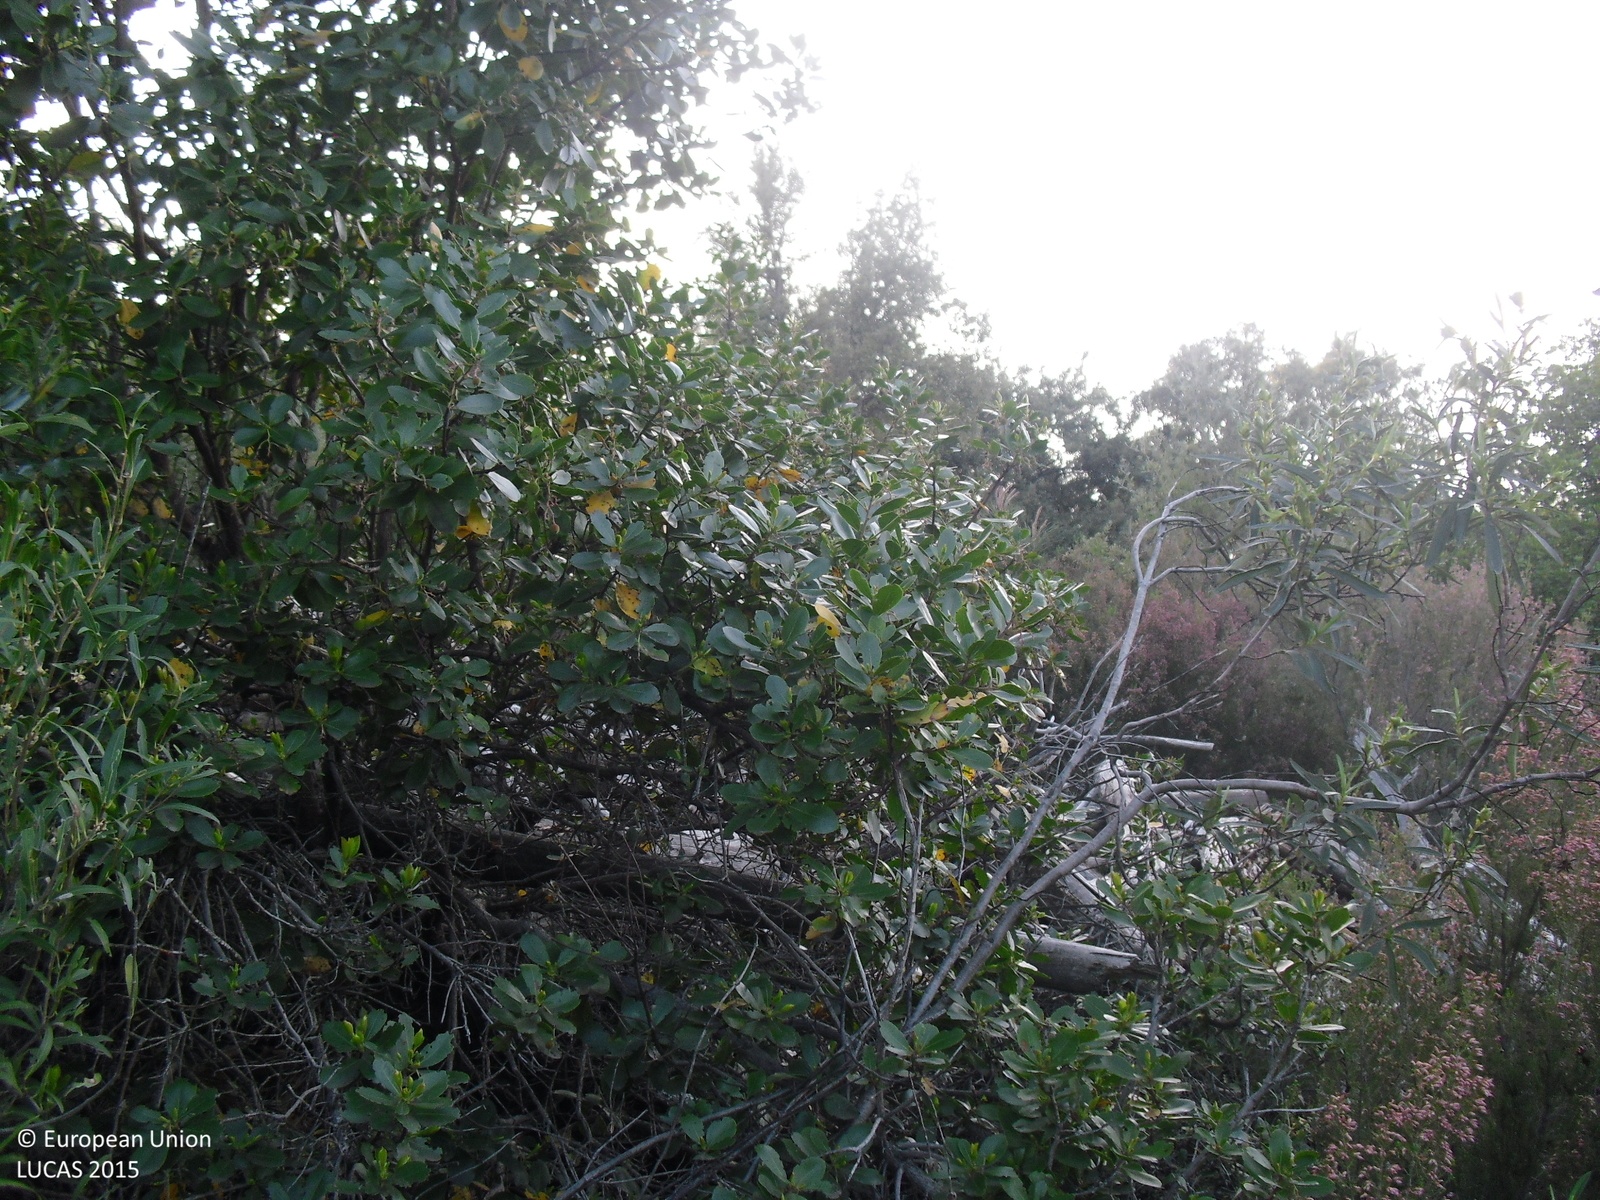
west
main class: Woodland
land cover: Broadleaved woodland
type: broadleaved evergreen forest
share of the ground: 10 - 25 %
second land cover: Shrubland without tree cover
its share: > 75 %
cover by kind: shrubs 70 %, broadleaved forest trees 20 %, herbaceous plants 10 %
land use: Forestry
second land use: Agriculture (excluding fallow land and kitchen gardens)
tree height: > 5 m
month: April
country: ES
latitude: 39.4269
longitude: -5.3002
